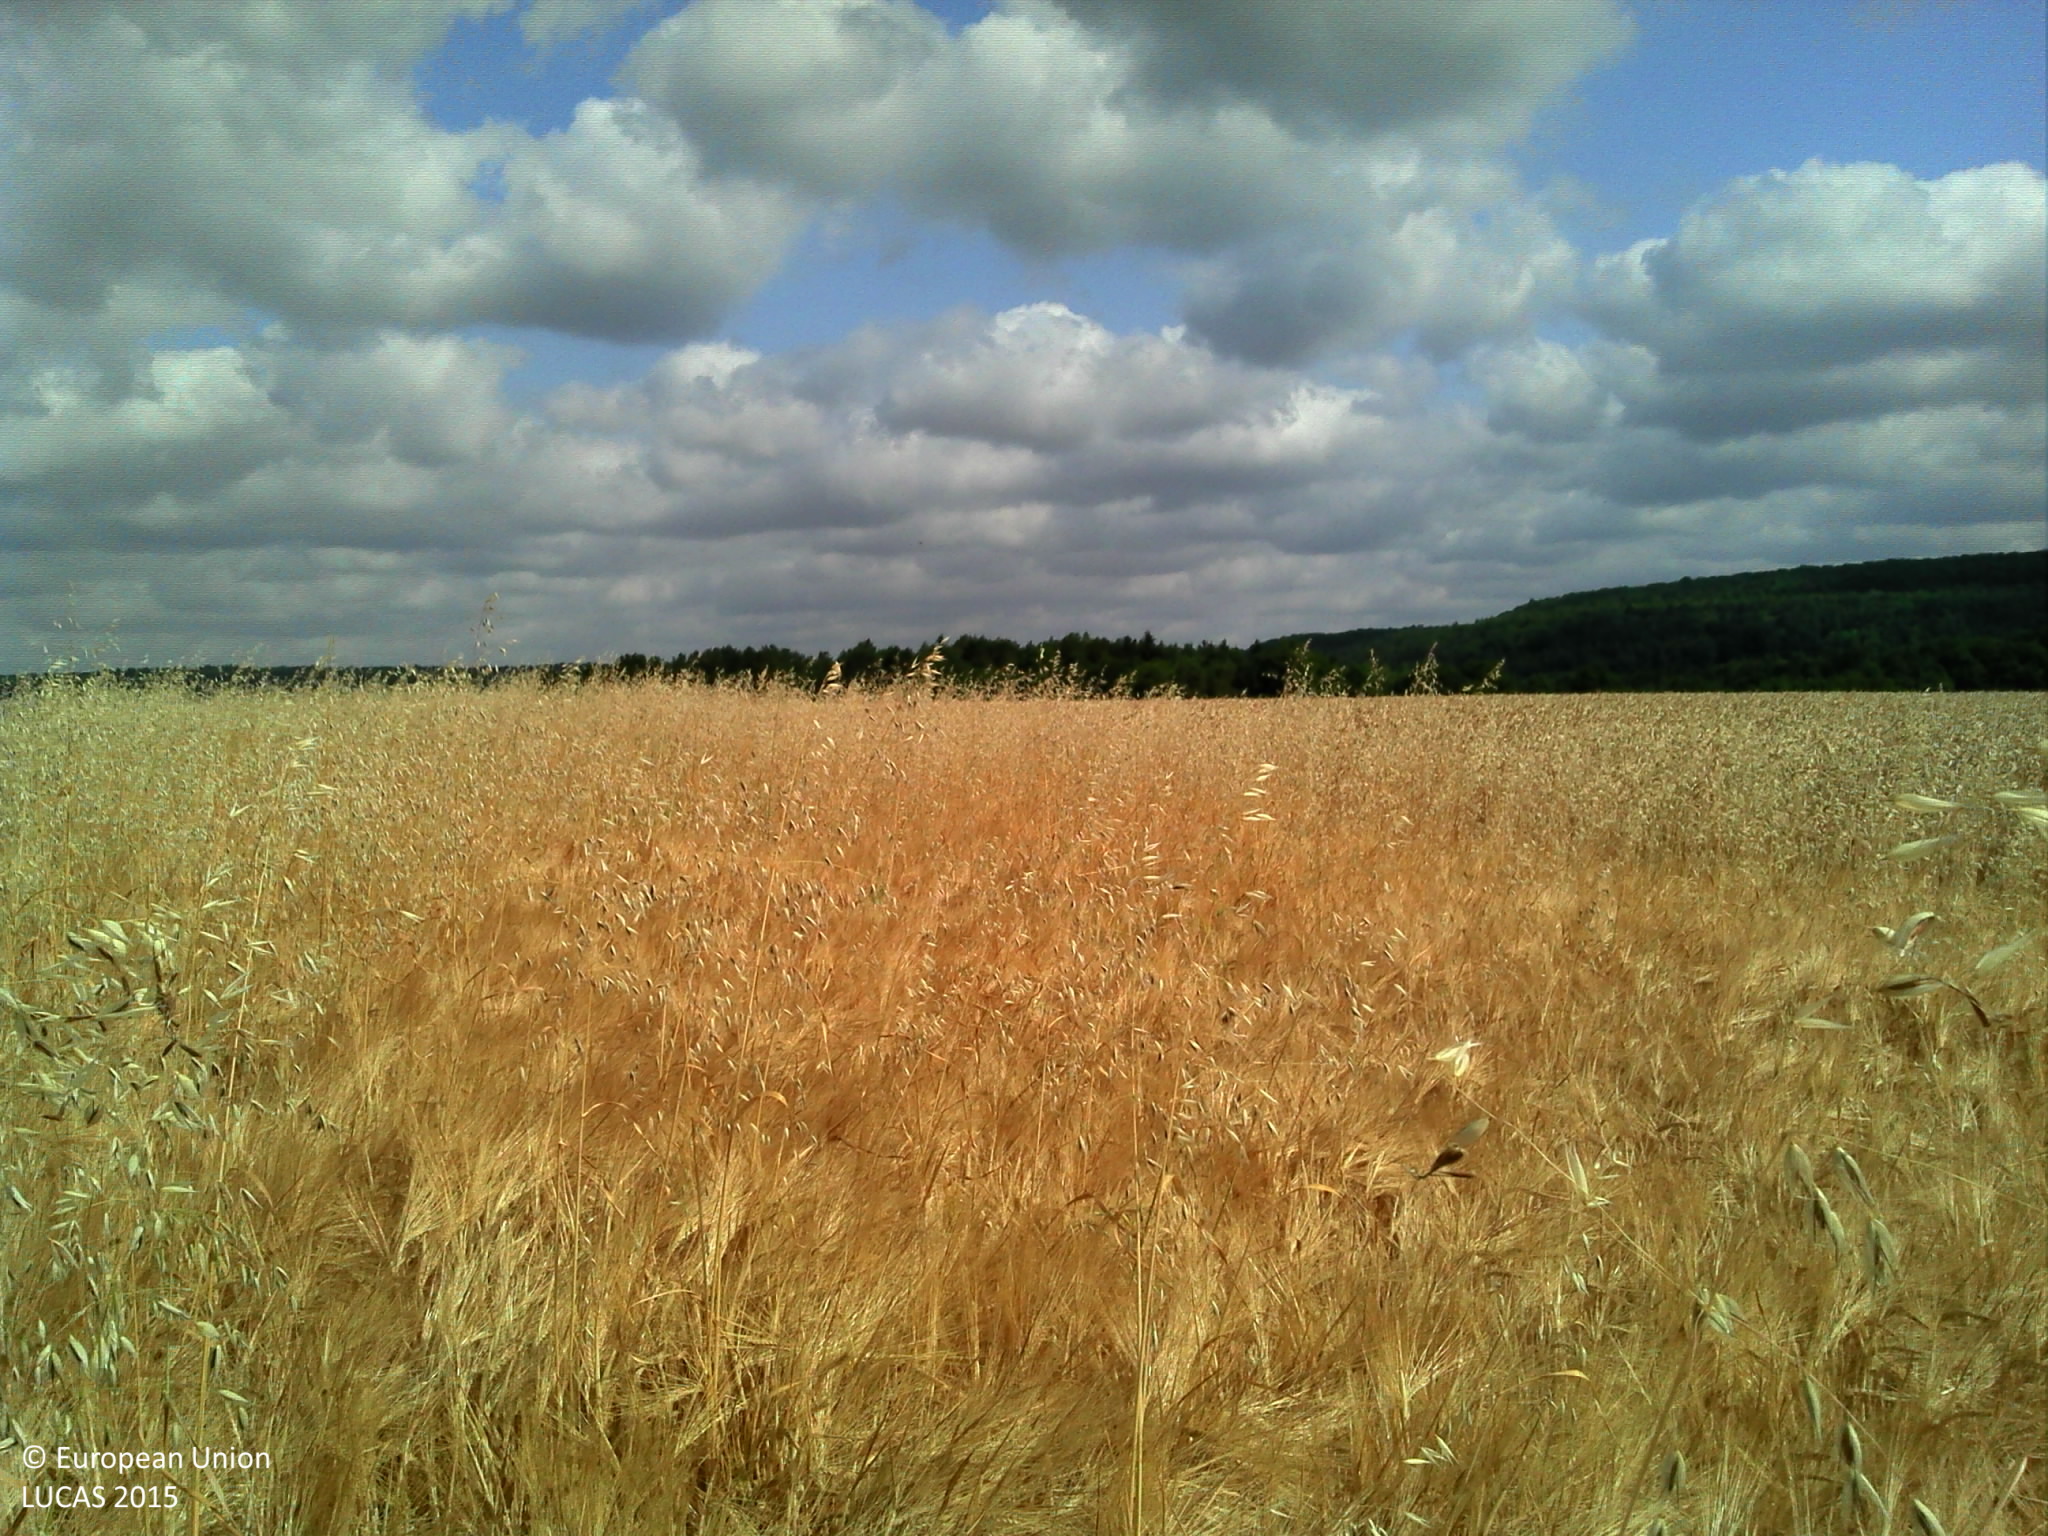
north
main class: Cropland
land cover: Barley
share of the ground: > 75 %
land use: Agriculture (excluding fallow land and kitchen gardens)
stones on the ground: 10 - 25 %
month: July
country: FR
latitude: 48.0306
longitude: 5.2388
